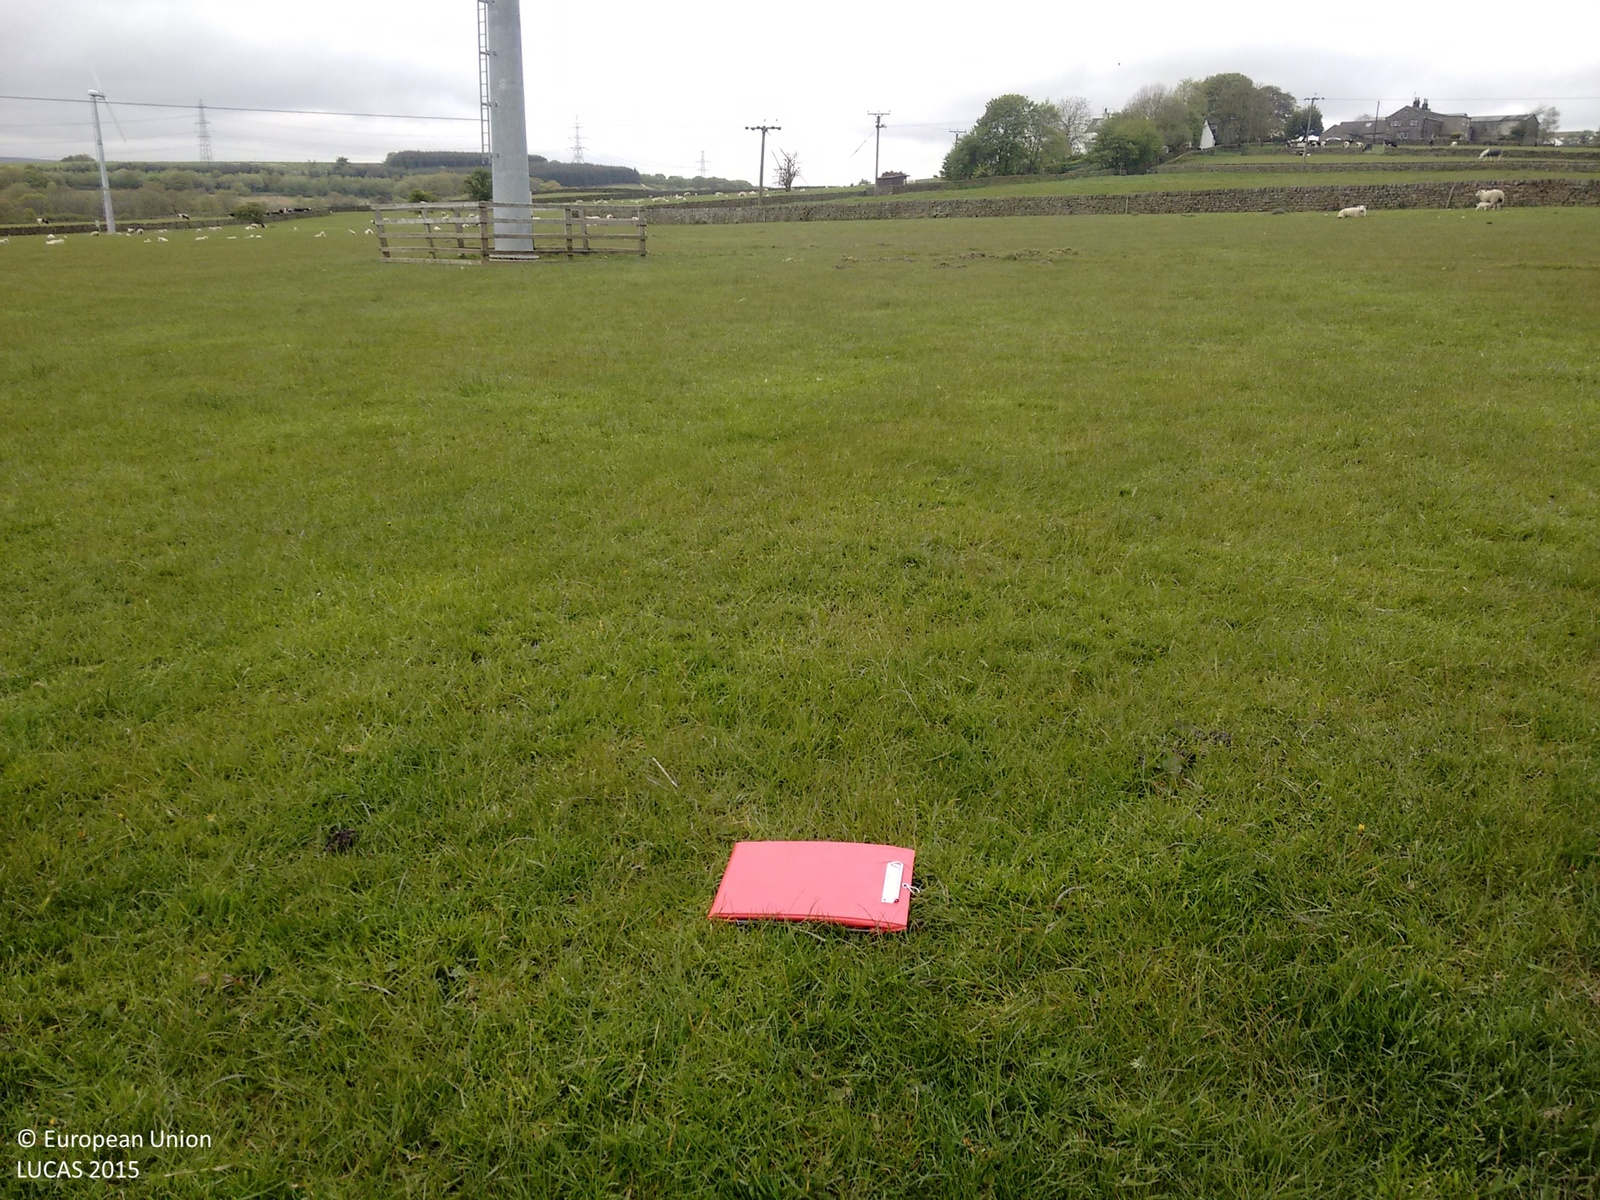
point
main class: Grassland
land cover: Grassland without tree/shrub cover
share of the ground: > 75 %
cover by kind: herbaceous plants 100 %
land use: Agriculture (excluding fallow land and kitchen gardens)
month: May
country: GB
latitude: 53.5248
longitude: -1.6826
